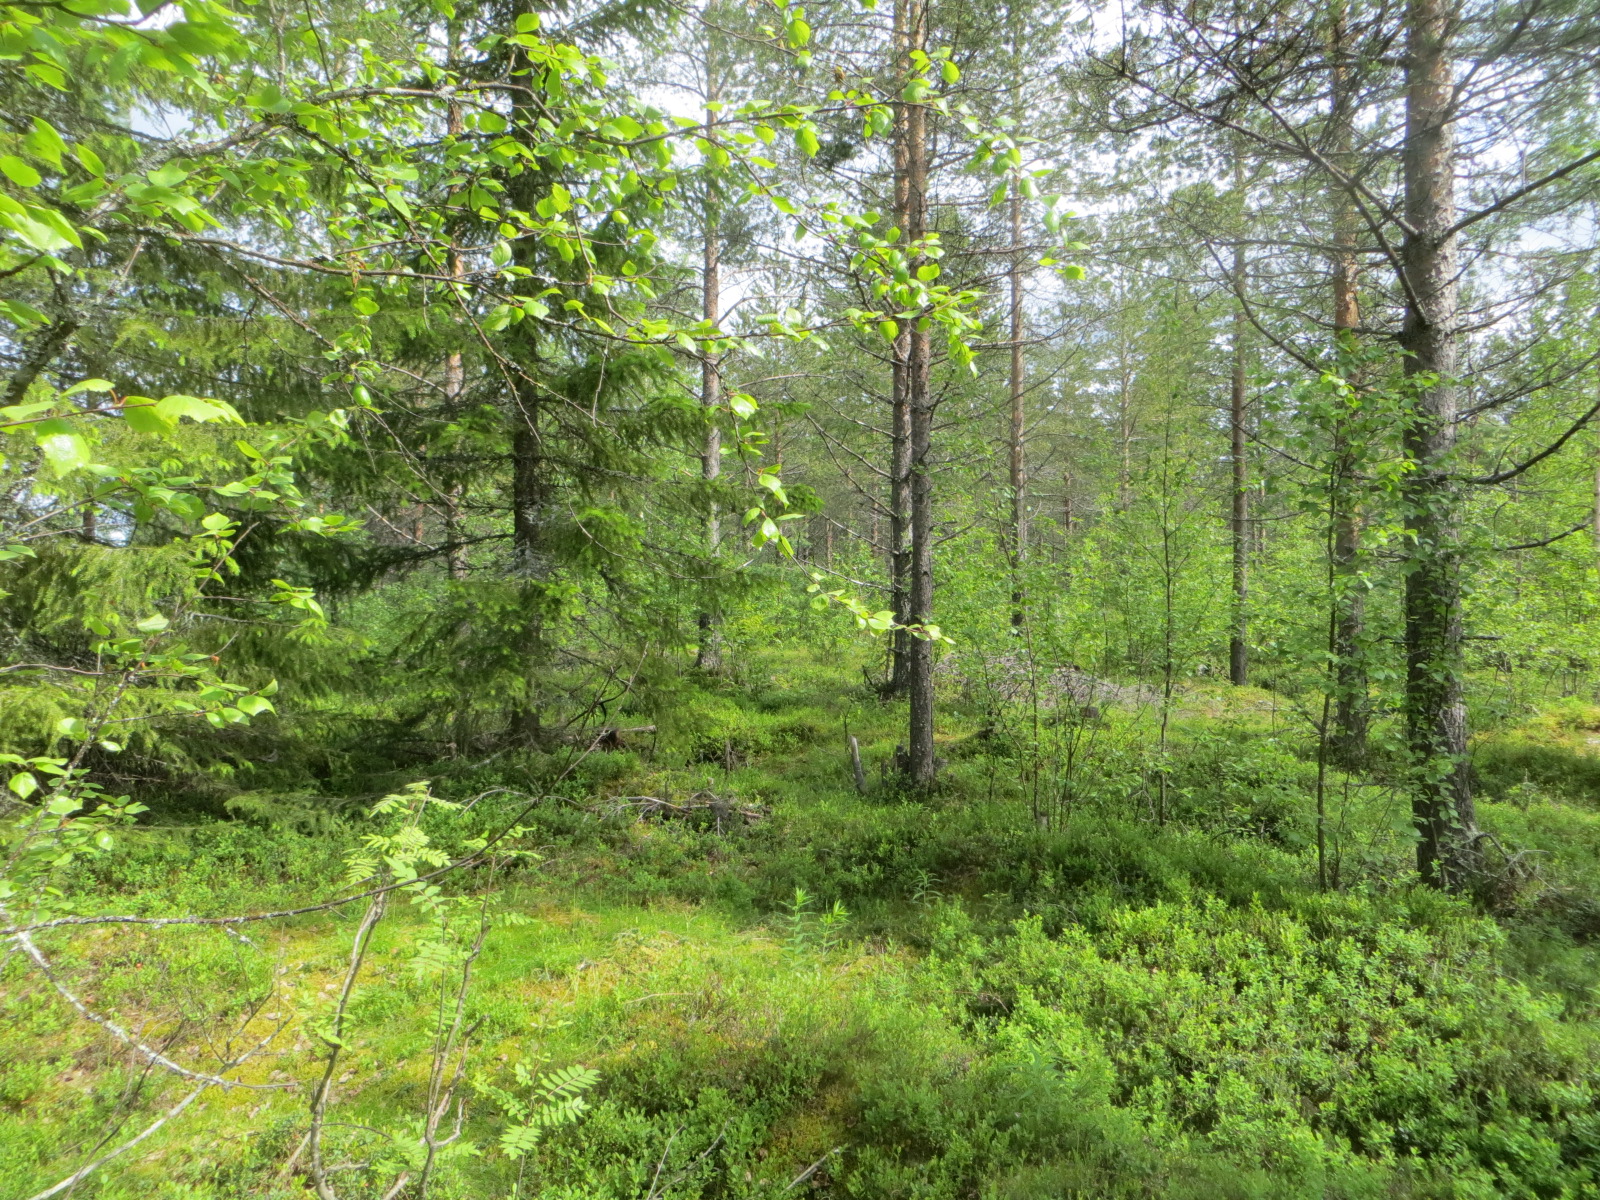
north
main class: Woodland
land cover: Pine dominated mixed woodland
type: boreal forest
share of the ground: 50 - 75 %
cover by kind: coniferous forest trees 40 %, broadleaved forest trees 30 %, shrubs 30 %
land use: Forestry
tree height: > 5 m
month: June
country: FI
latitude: 66.0023
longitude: 26.4204
